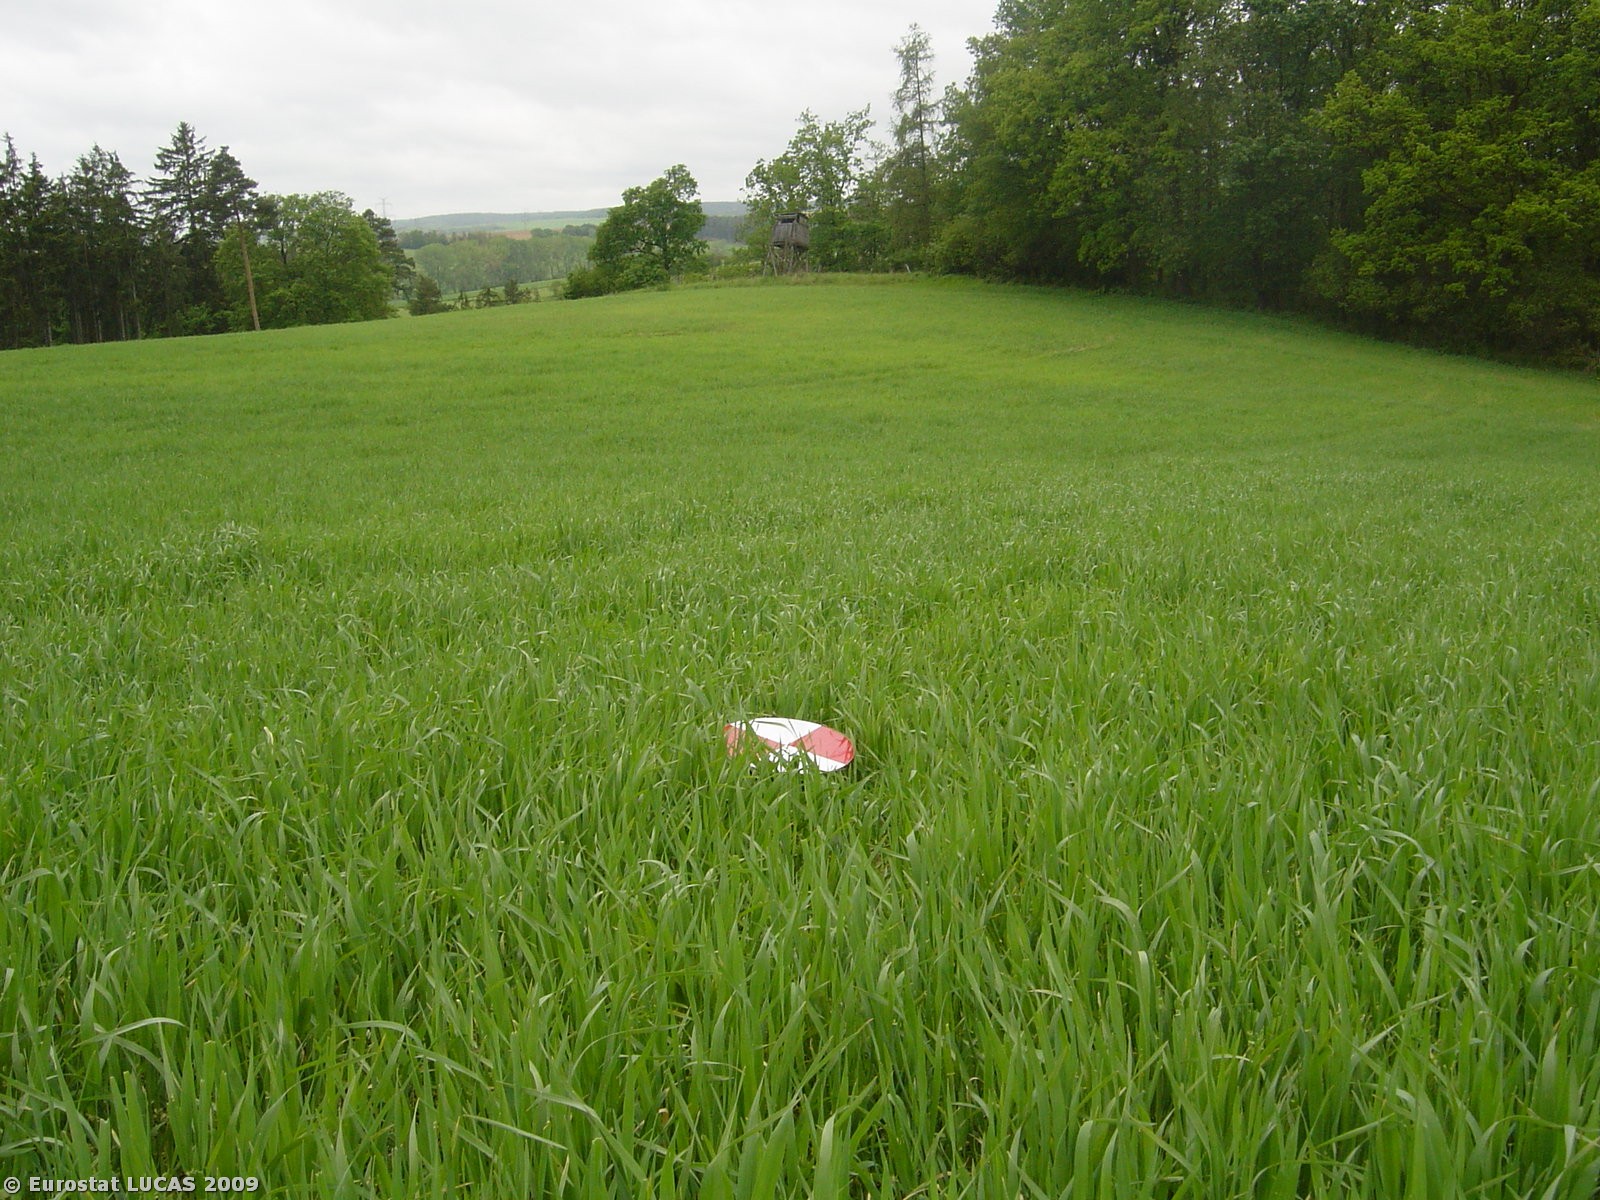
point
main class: Cropland
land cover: Barley
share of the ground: > 75 %
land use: Agriculture (excluding fallow land and kitchen gardens)
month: May
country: CZ
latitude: 49.2439
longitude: 16.4490
